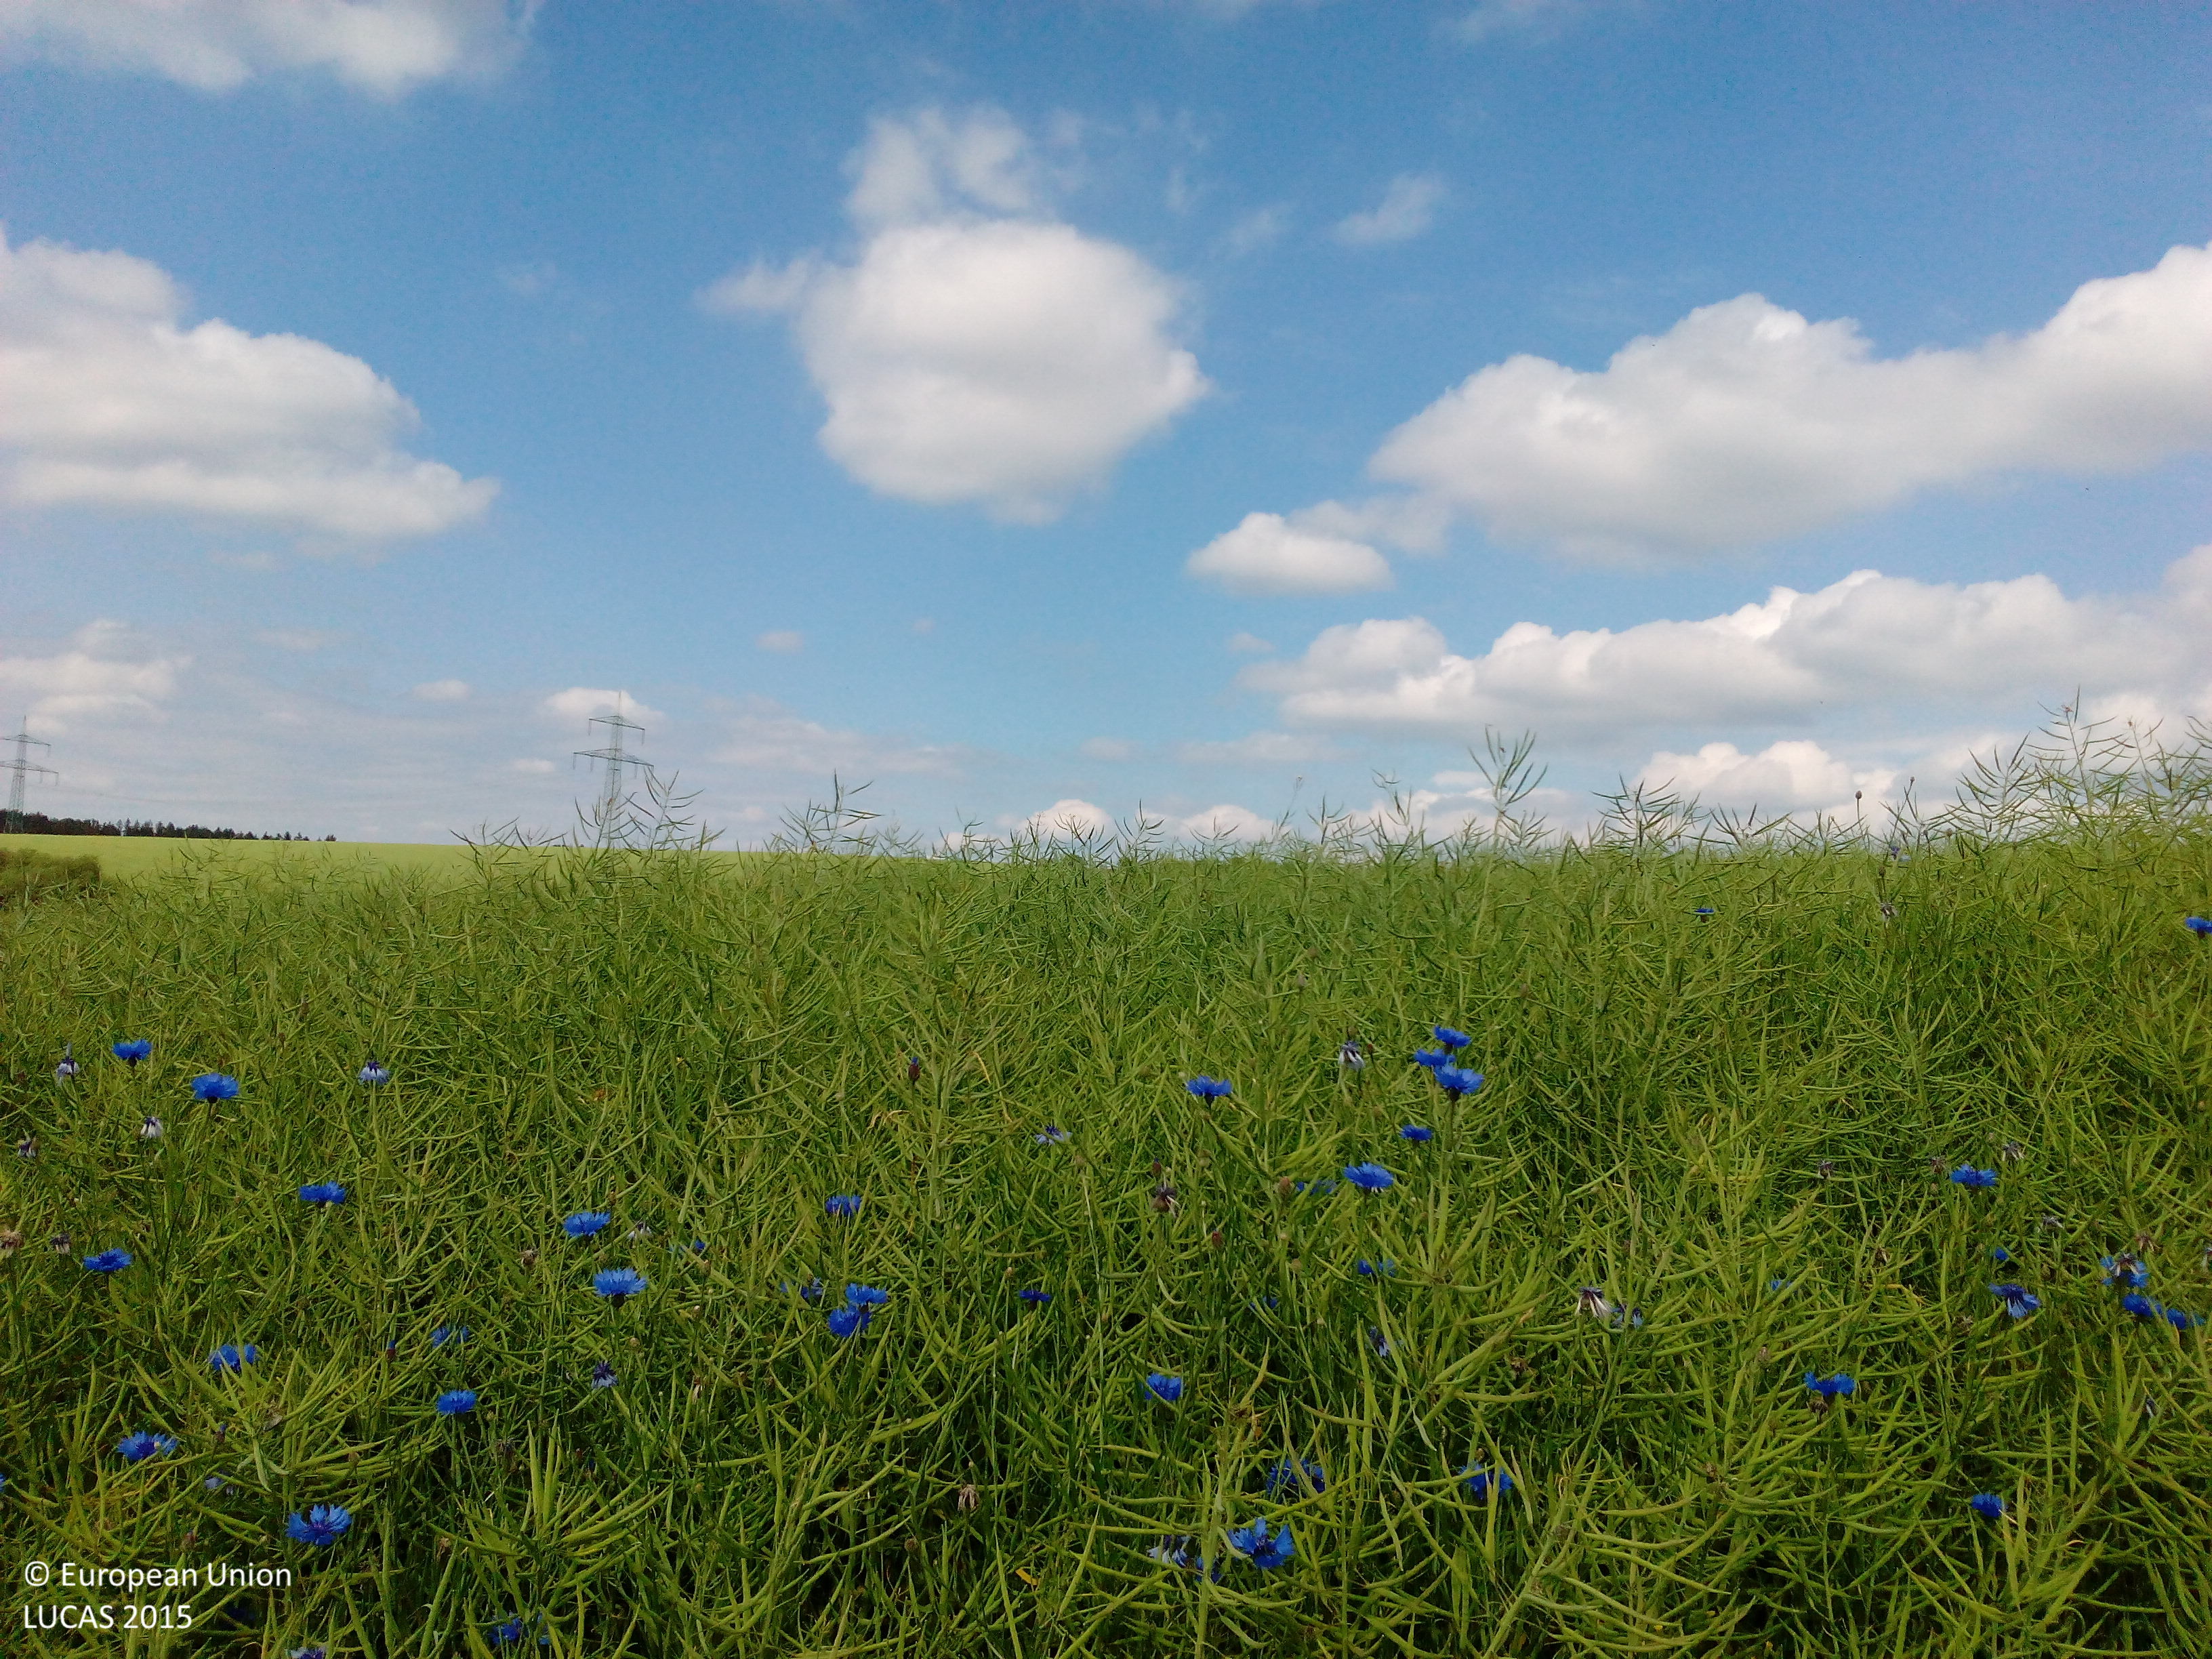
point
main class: Cropland
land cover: Rape and turnip rape
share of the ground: > 75 %
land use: Agriculture (excluding fallow land and kitchen gardens)
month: June
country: DE
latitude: 50.6578
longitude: 11.6547
